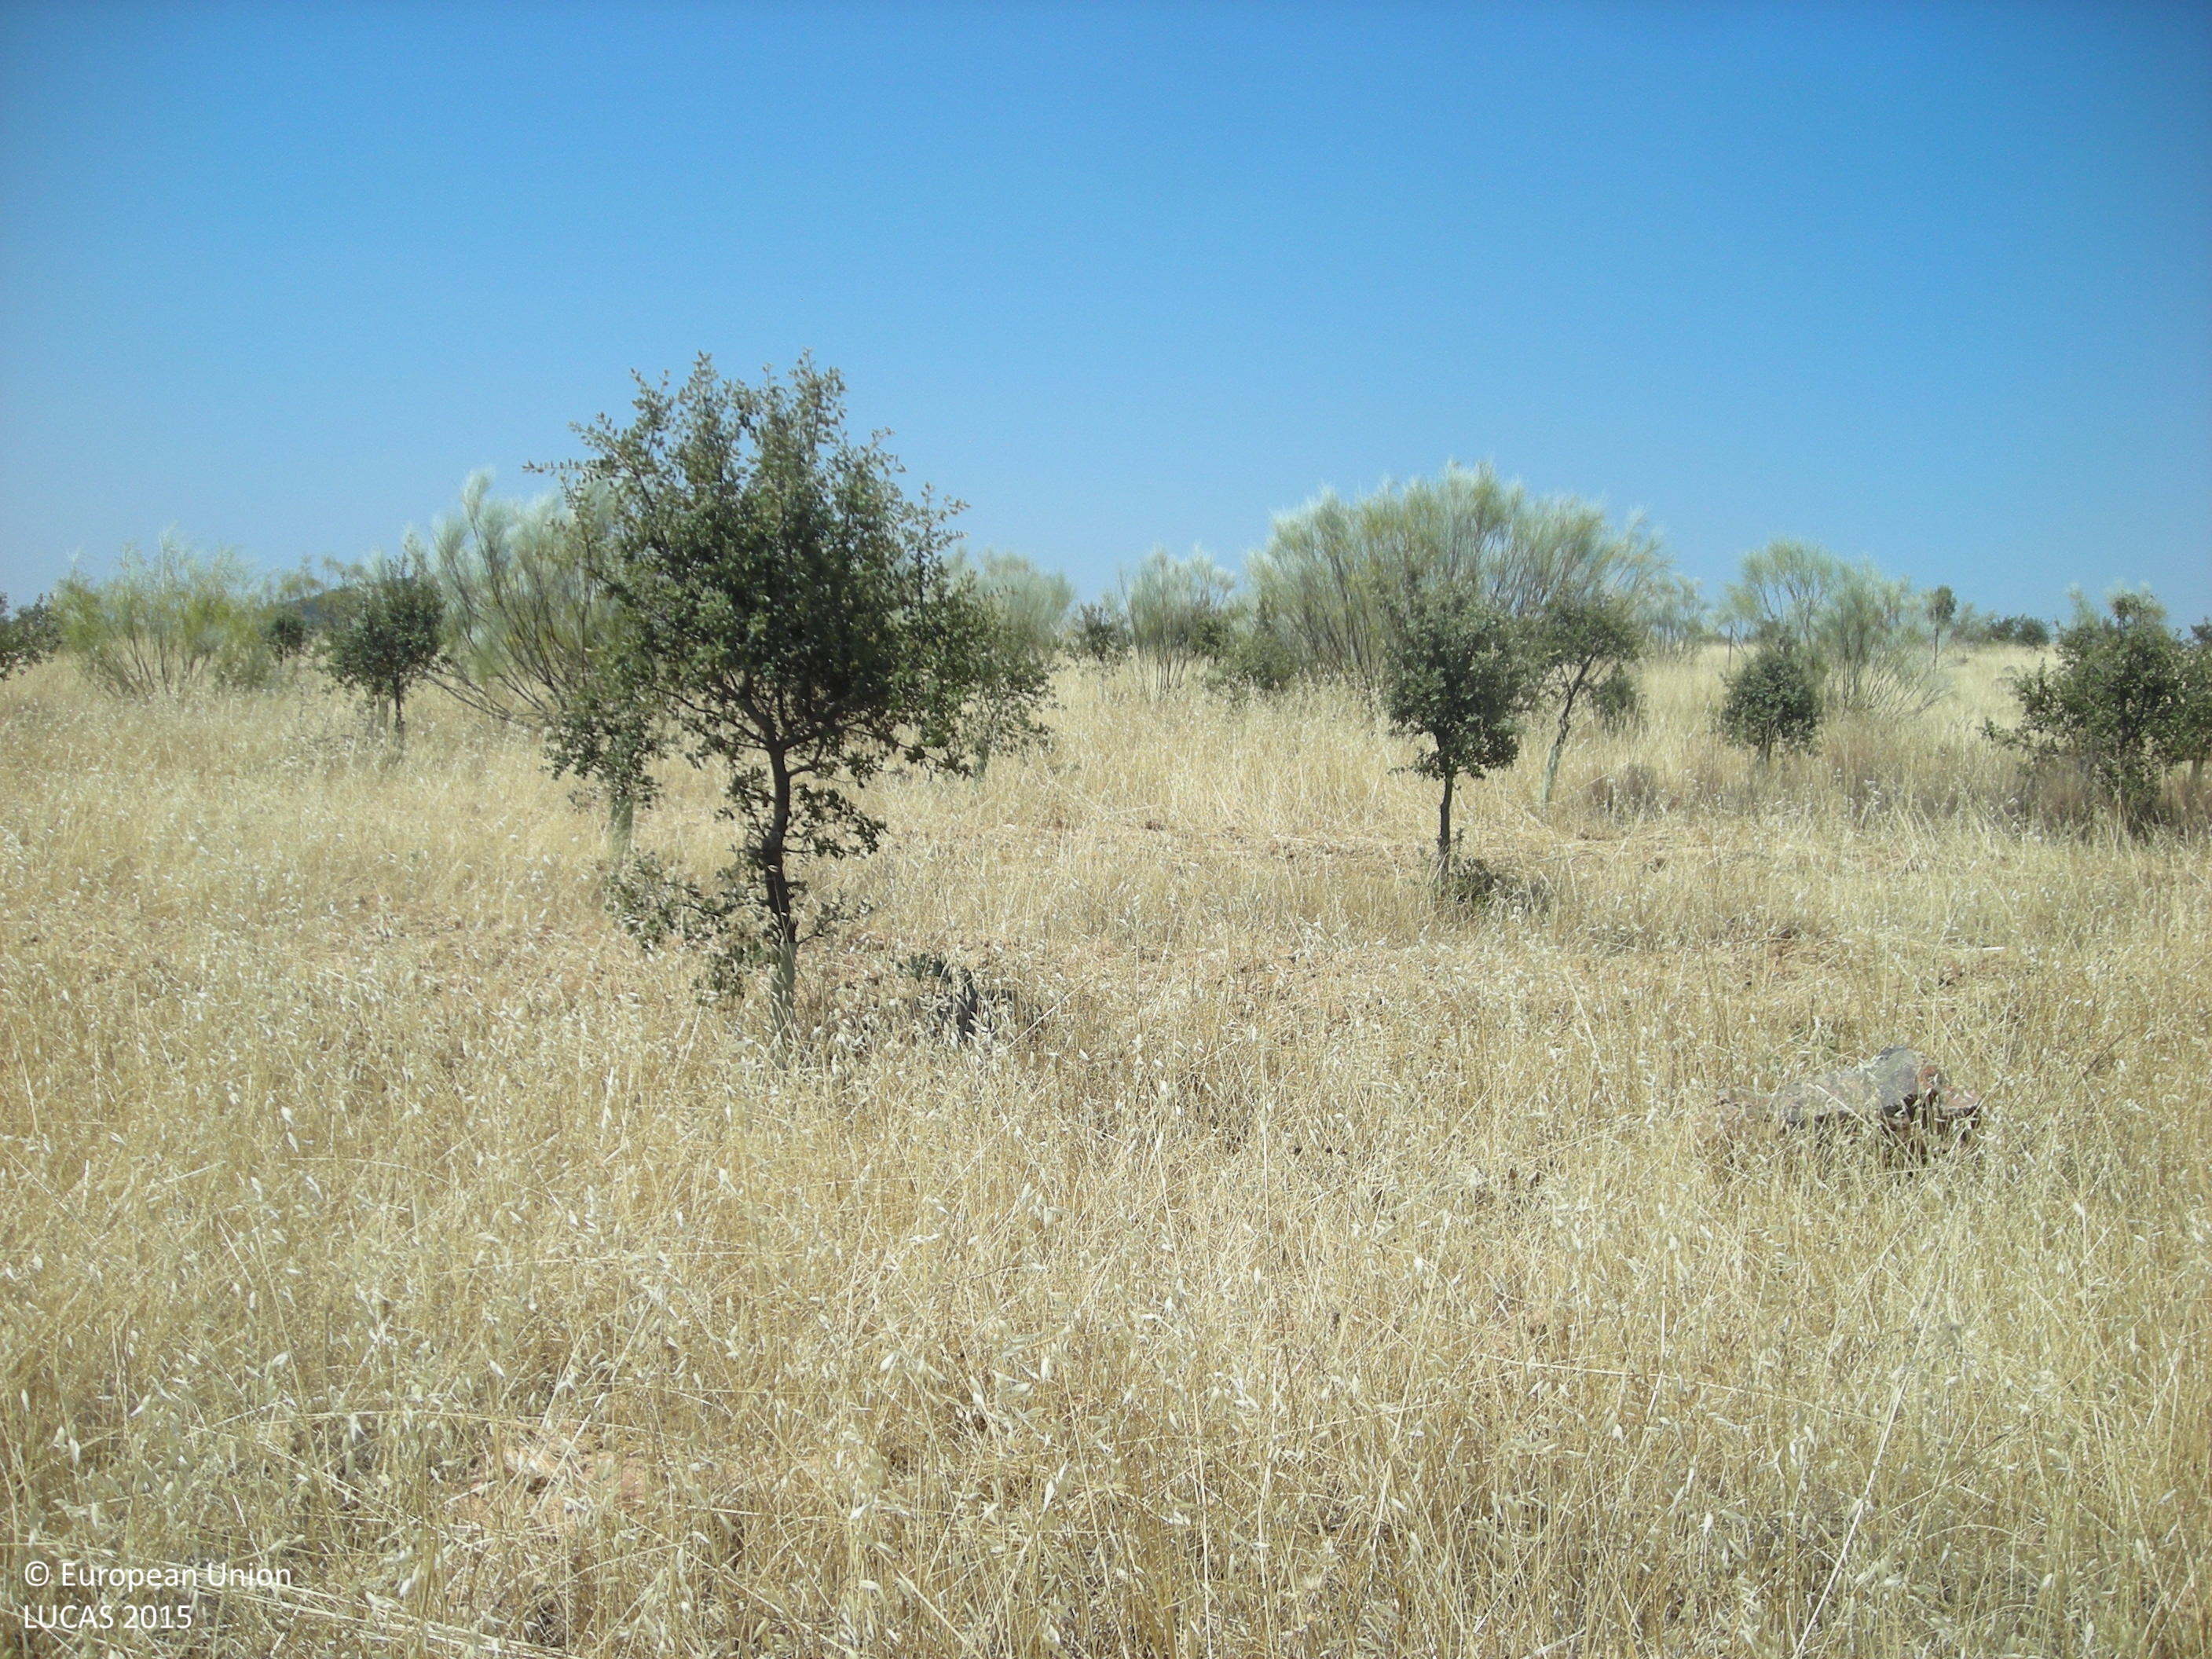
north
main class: Woodland
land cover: Broadleaved woodland
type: broadleaved evergreen forest
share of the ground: > 75 %
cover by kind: herbaceous plants 60 %, broadleaved forest trees 40 %
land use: Forestry
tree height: > 5 m
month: June
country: ES
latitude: 38.7005
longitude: -5.8083
